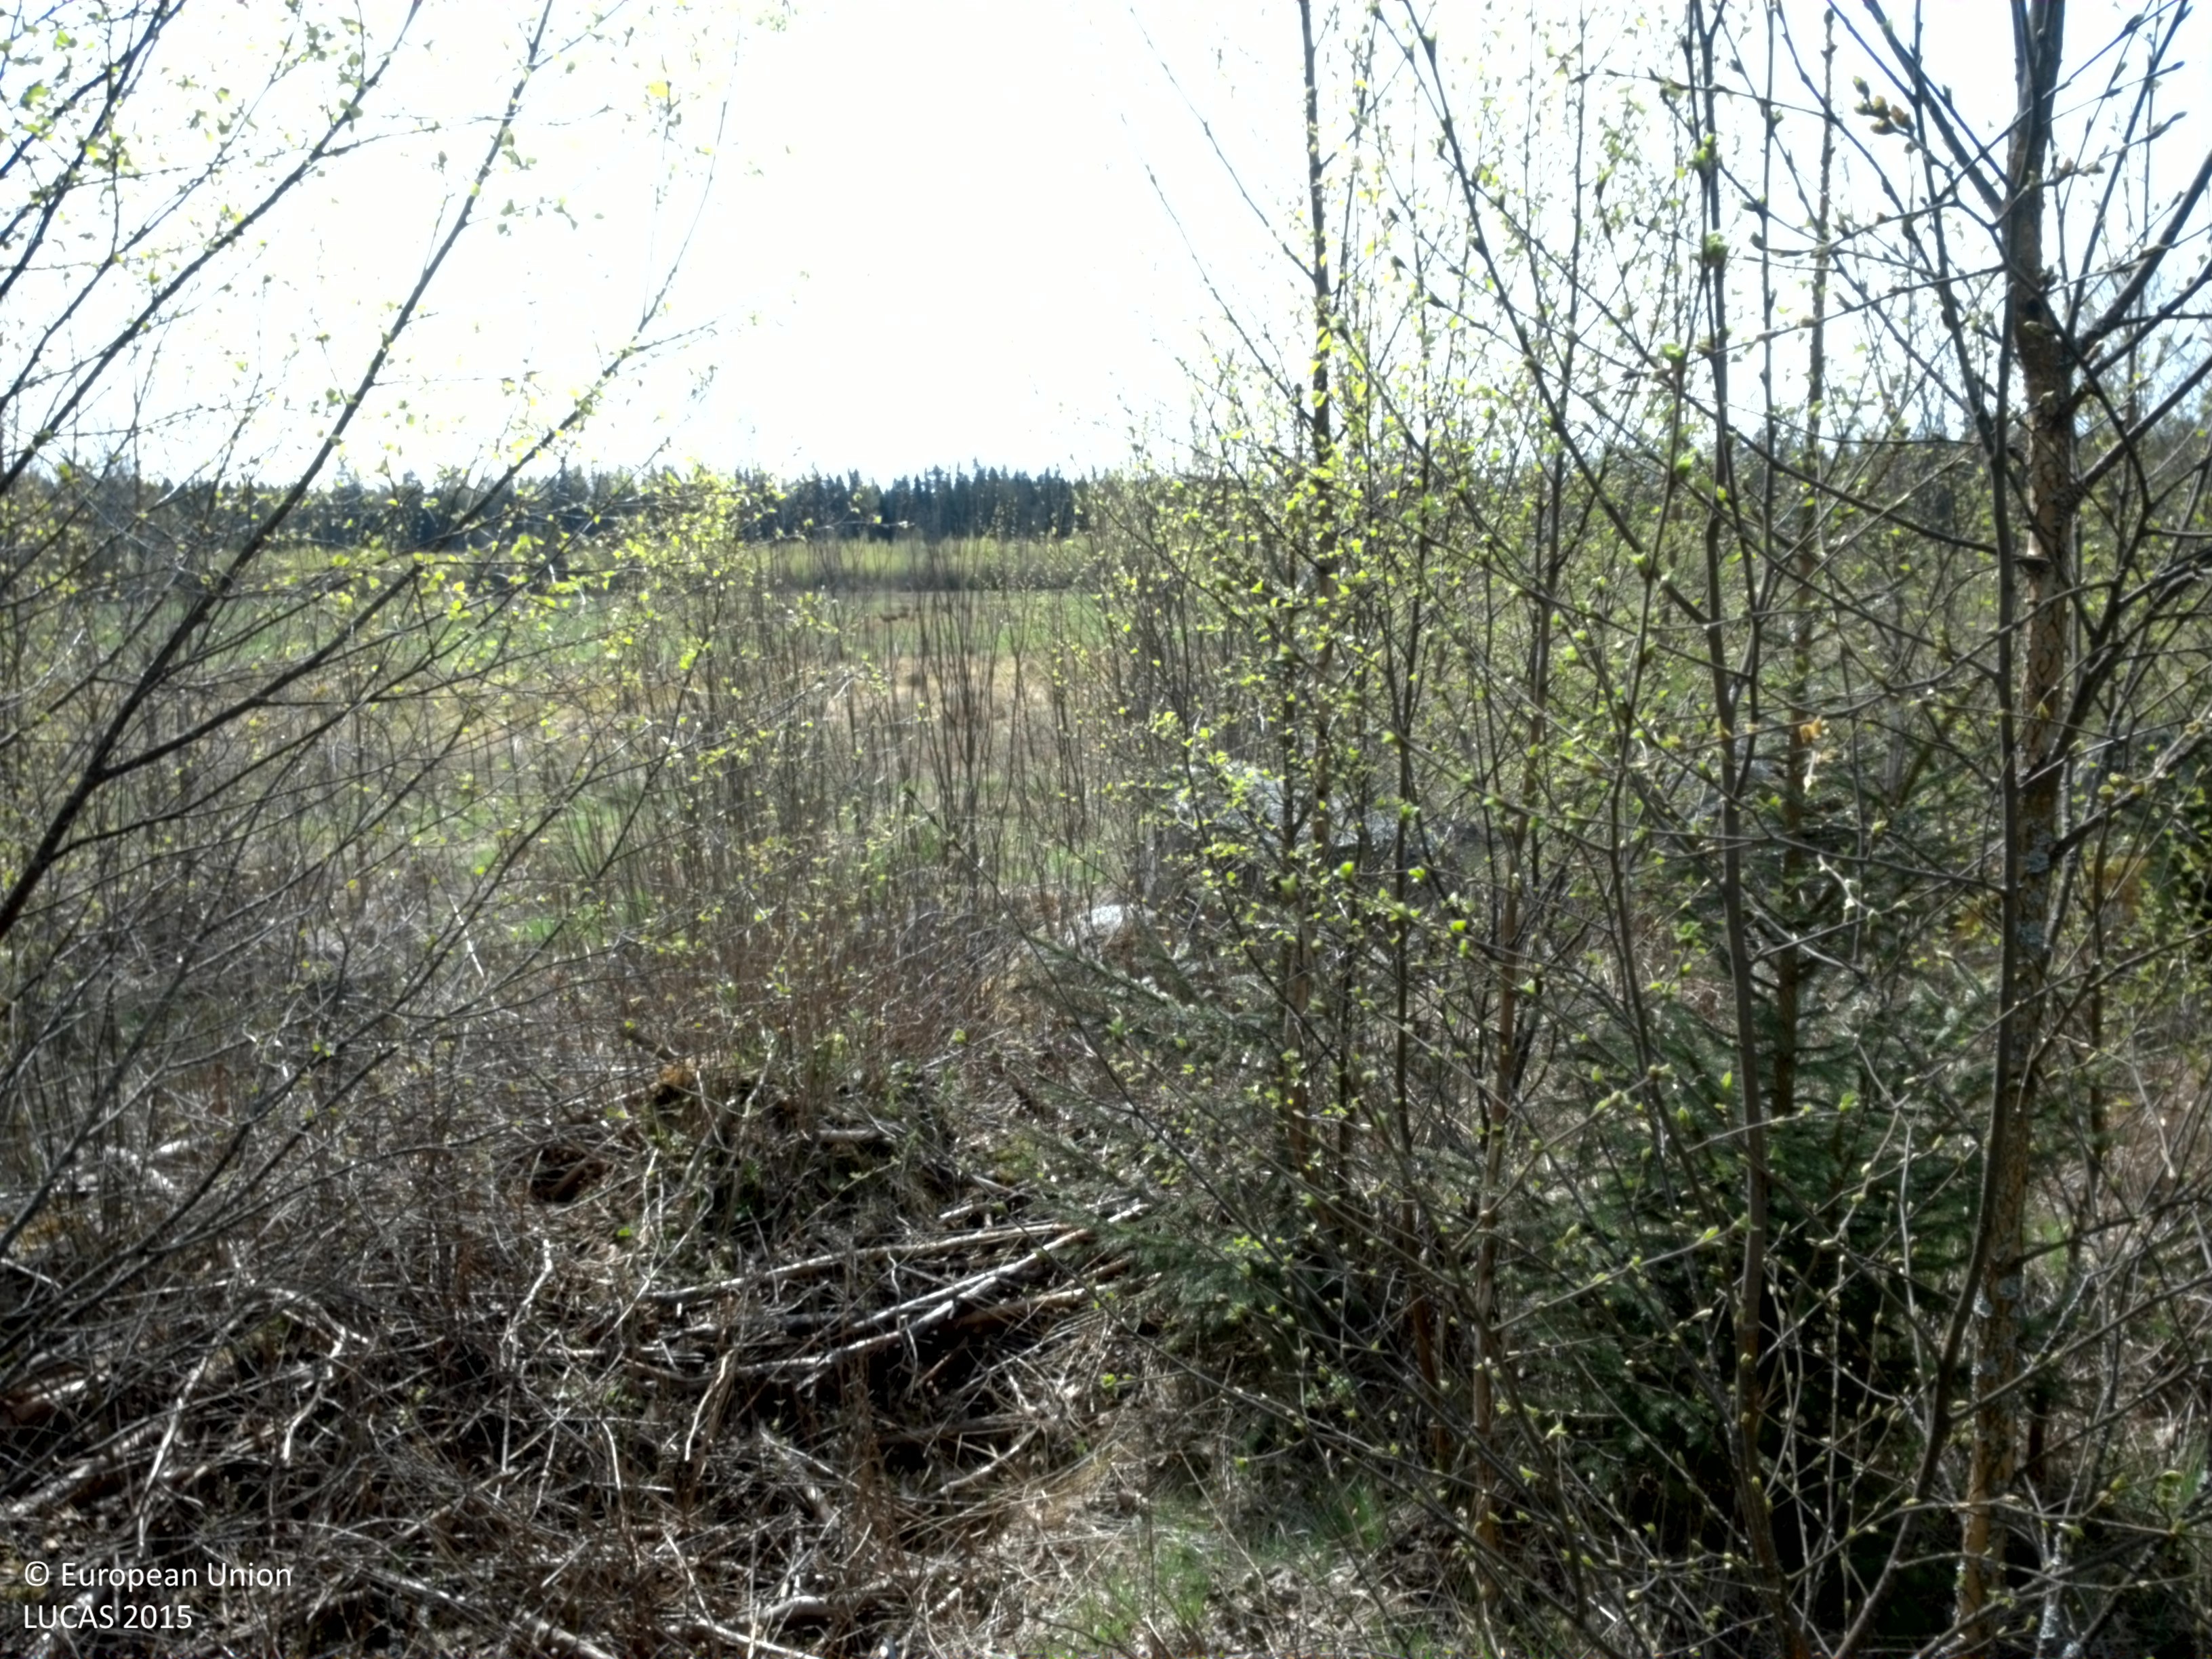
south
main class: Woodland
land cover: Broadleaved woodland
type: boreal forest
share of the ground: > 75 %
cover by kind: broadleaved forest trees 75 %, coniferous forest trees 15 %, shrubs 5 %, herbaceous plants 5 %
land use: Forestry
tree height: < 5 m
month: May
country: SE
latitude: 56.7995
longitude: 14.8278
